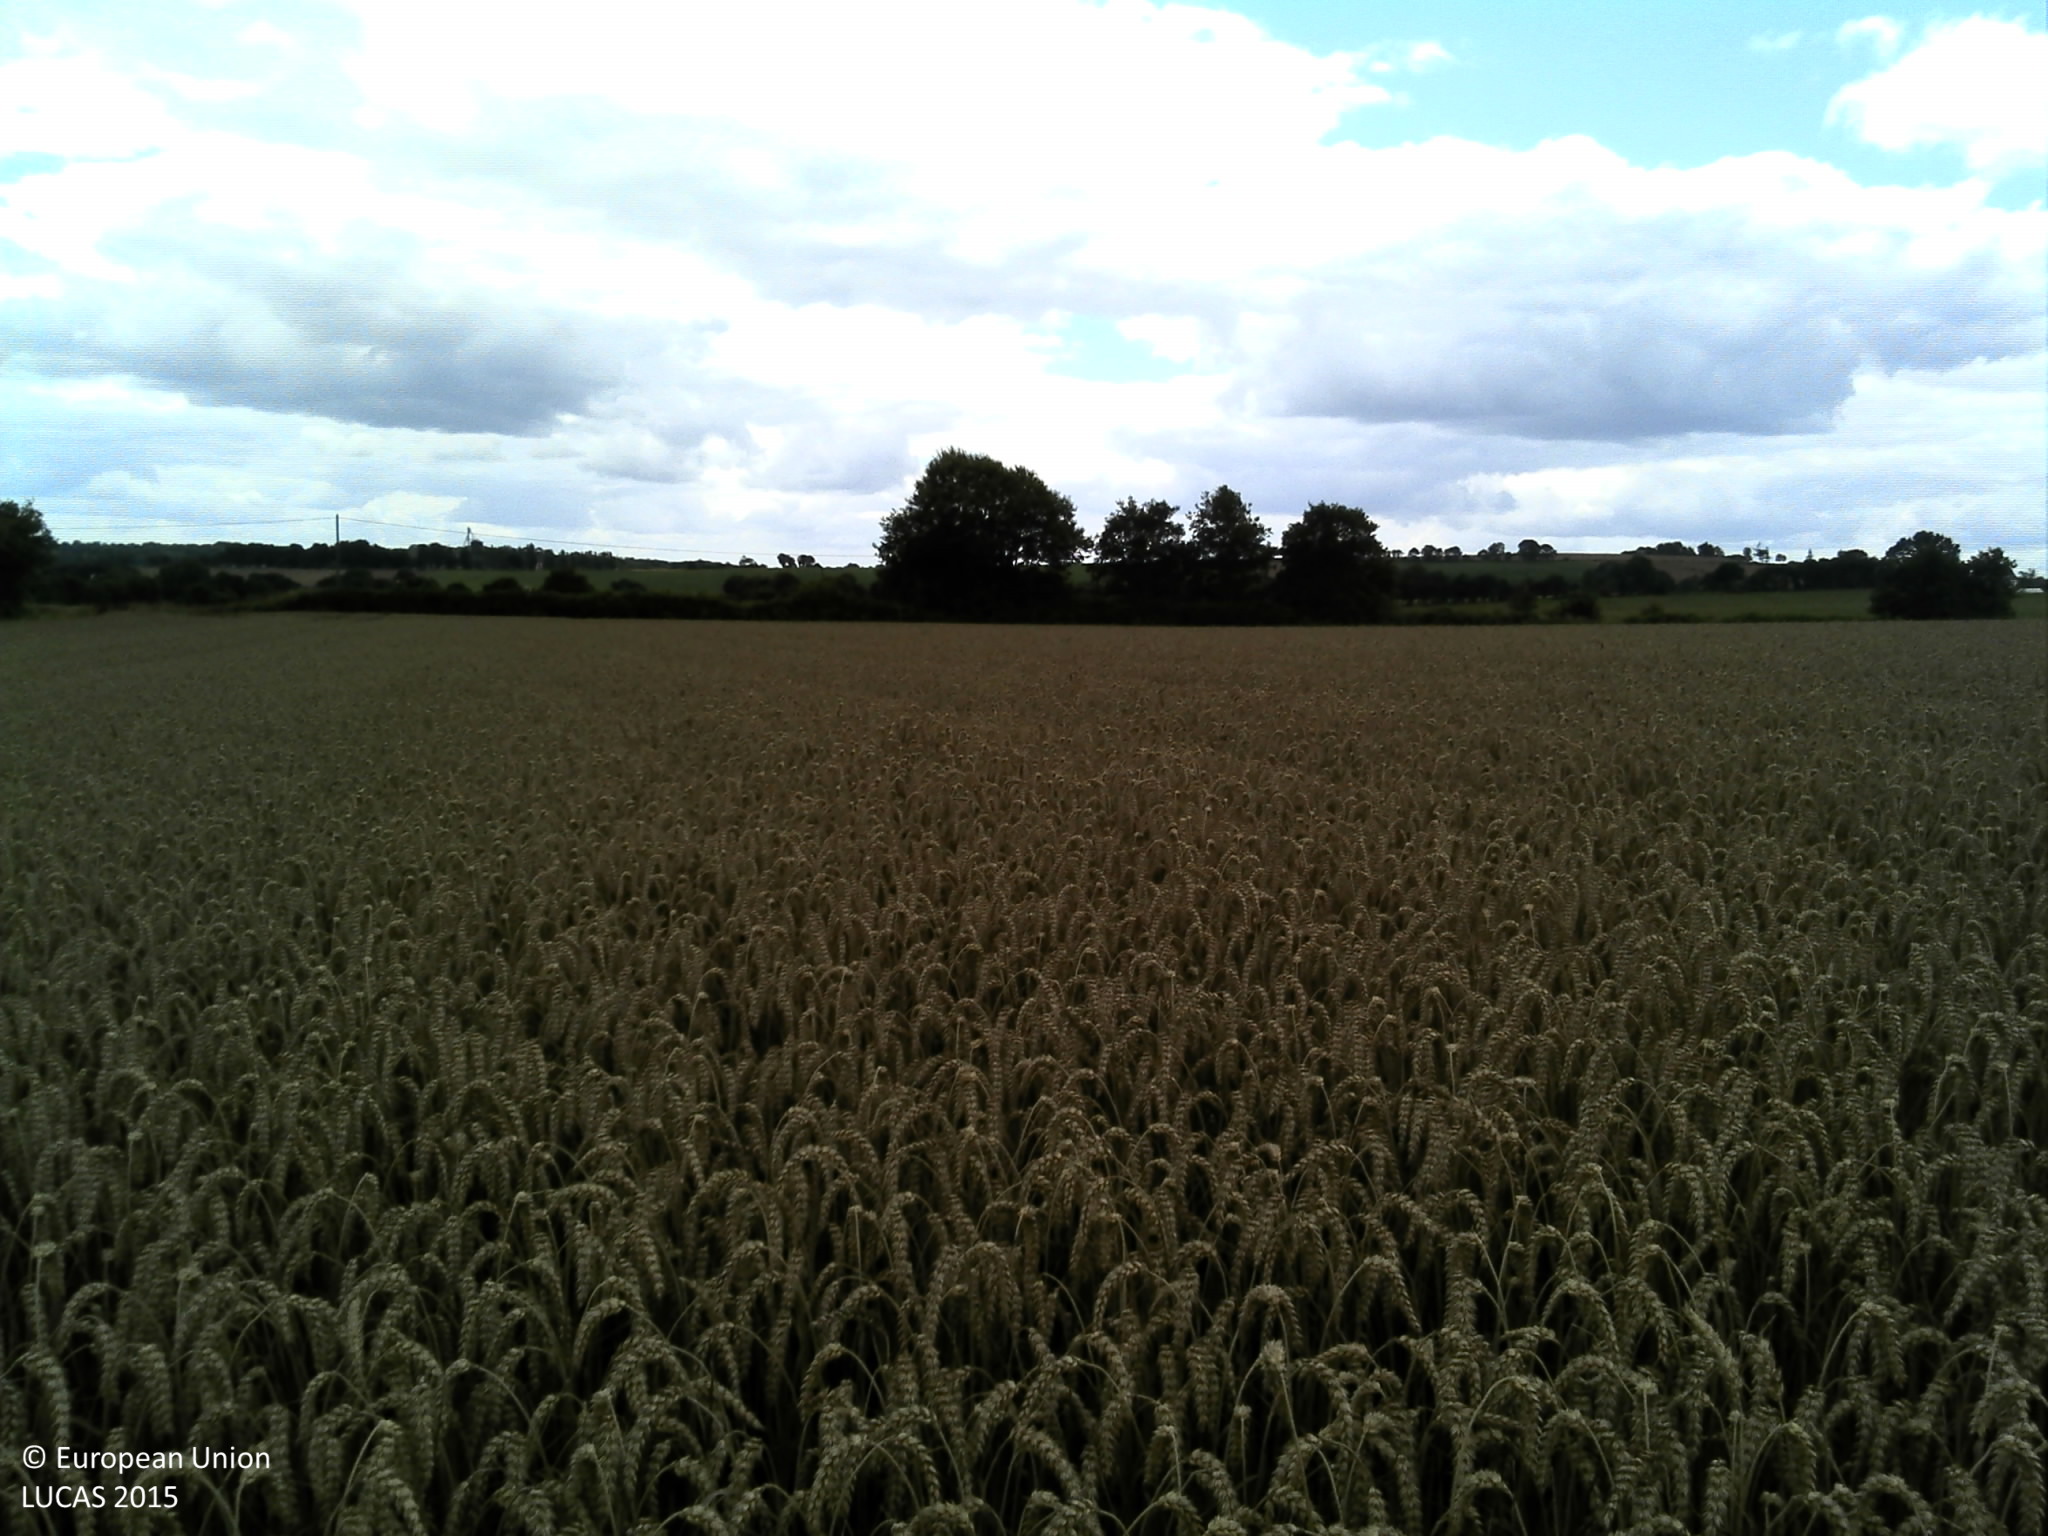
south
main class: Cropland
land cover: Common wheat
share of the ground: > 75 %
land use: Agriculture (excluding fallow land and kitchen gardens)
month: July
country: FR
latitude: 48.2994
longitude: -3.6560
